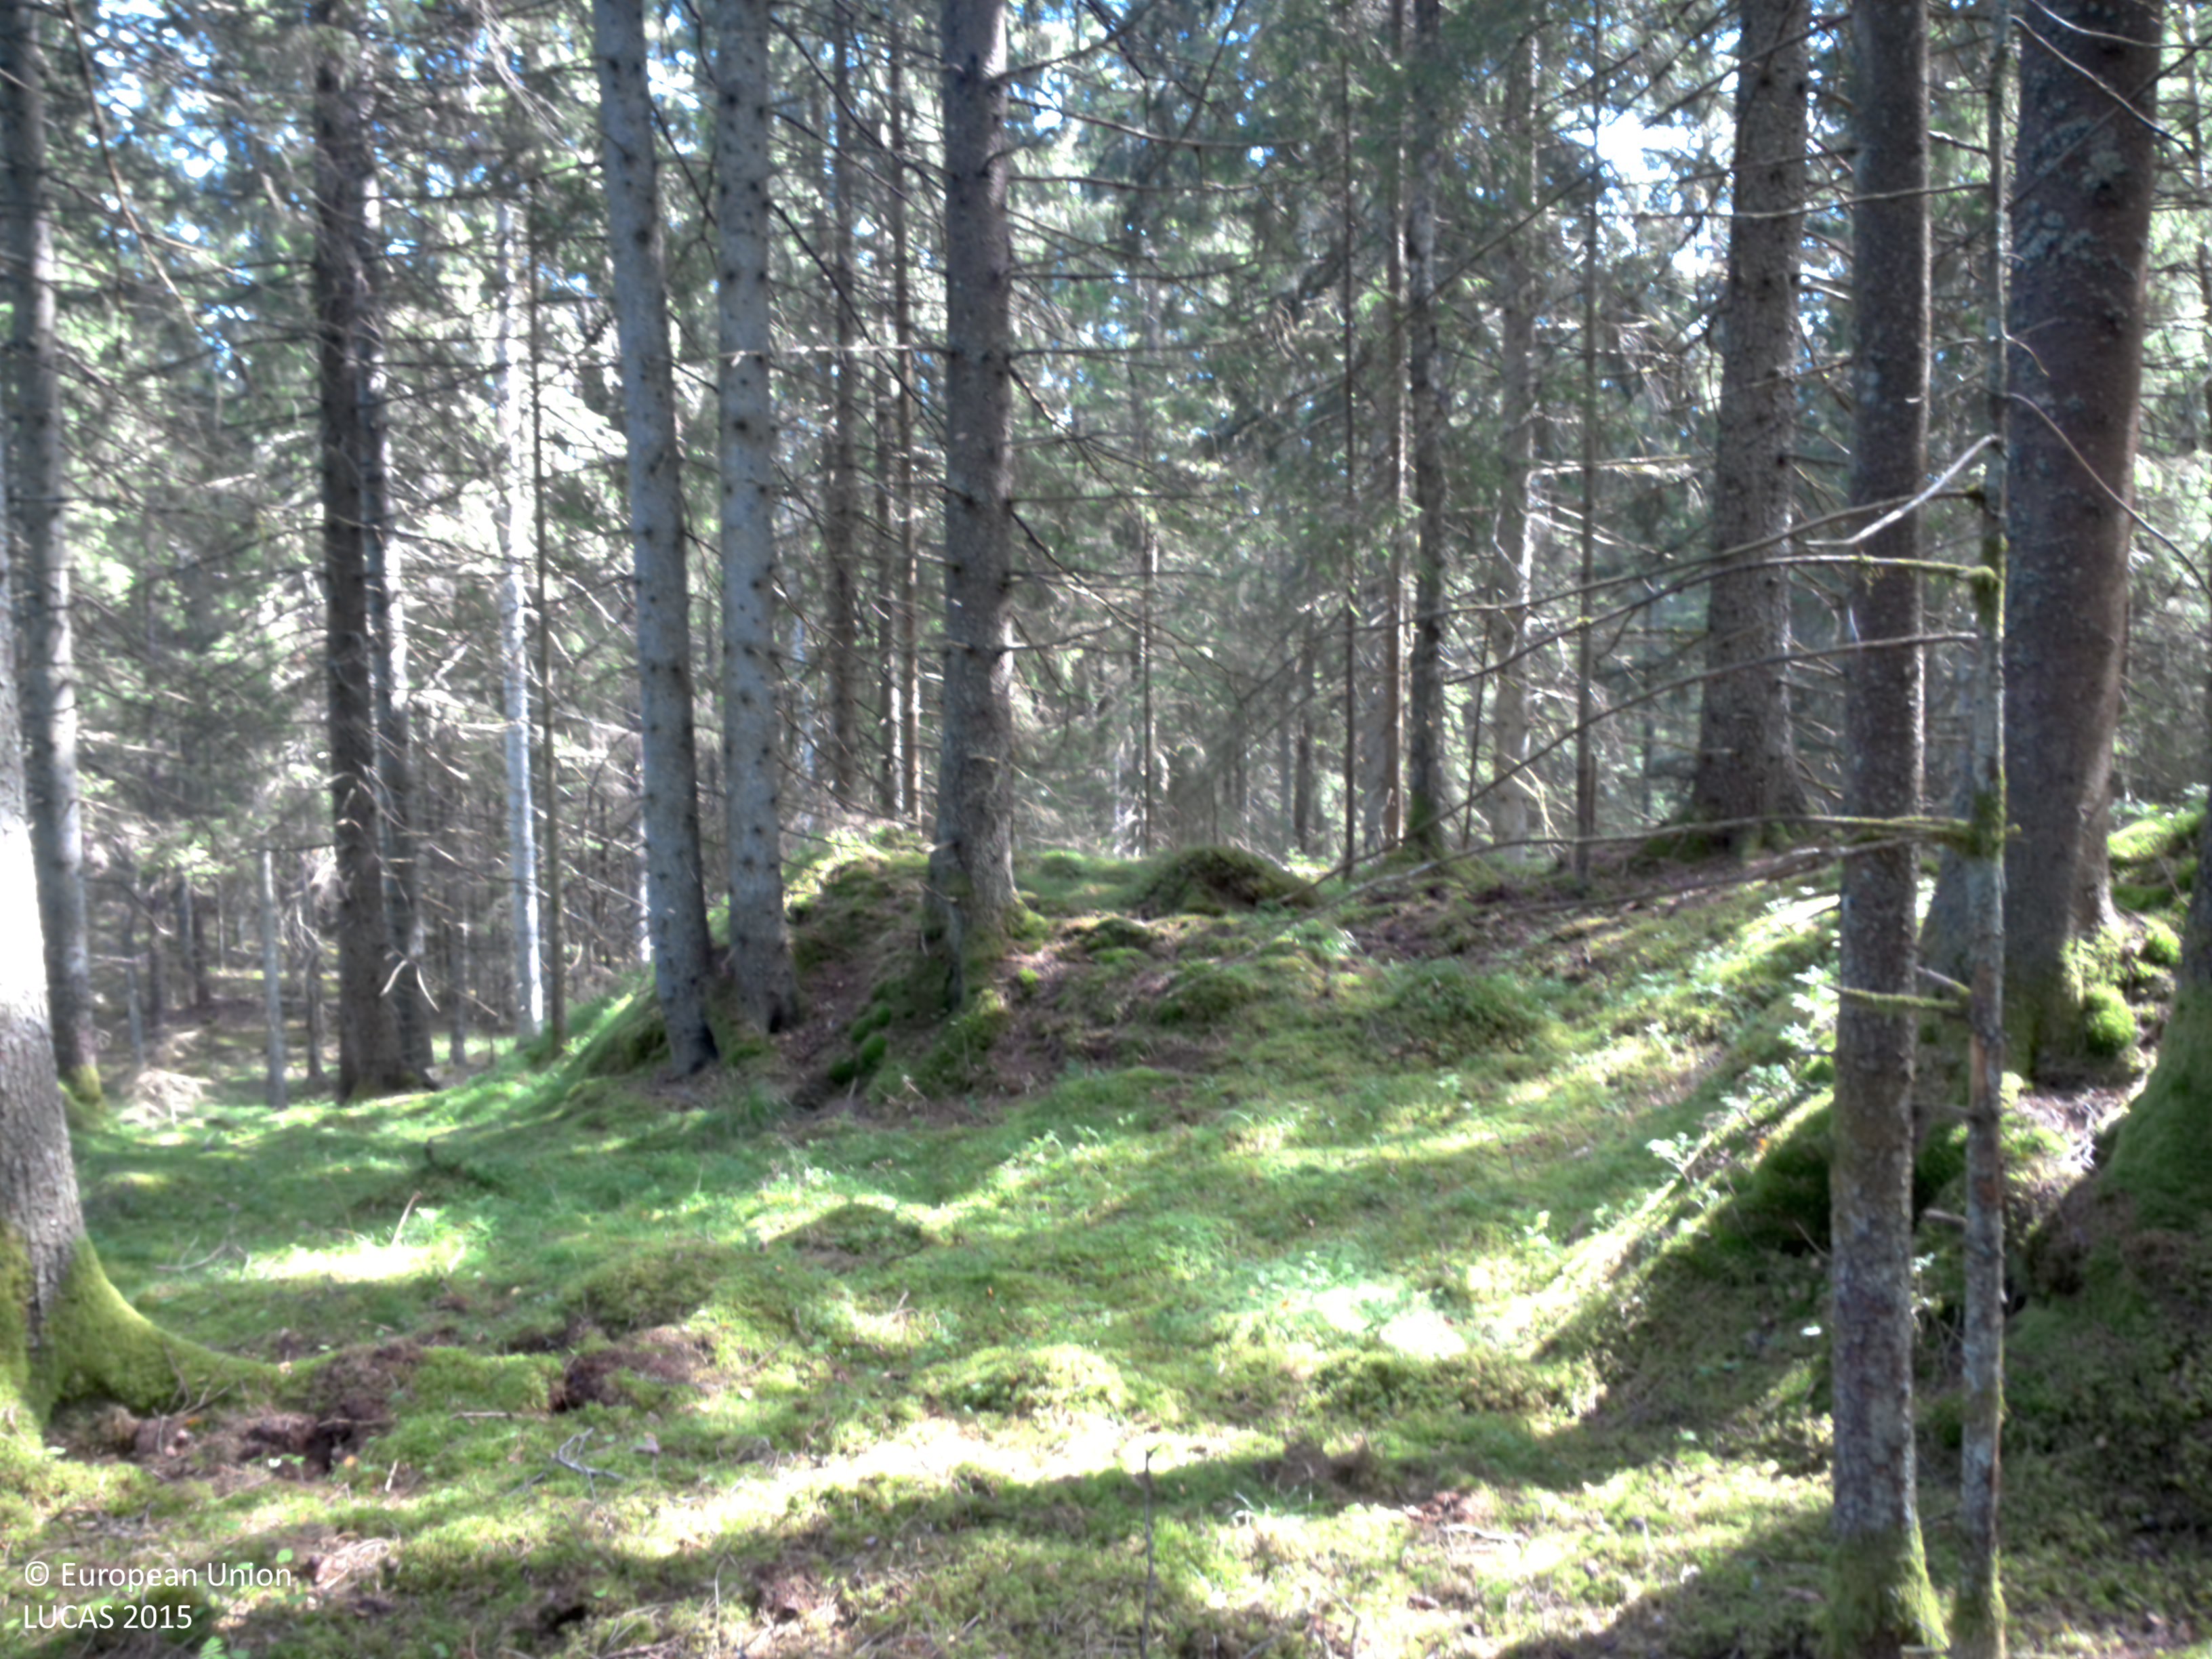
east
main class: Woodland
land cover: Spruce dominated coniferous woodland
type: boreal forest
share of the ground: 50 - 75 %
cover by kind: coniferous forest trees 60 %, lichens and mosses 30 %, shrubs 10 %
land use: Forestry
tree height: > 5 m
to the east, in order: Spruce dominated coniferous woodland; Spruce dominated mixed woodland; Ditches and canals; Spruce dominated coniferous woodland; Ditches and canals; Spruce dominated mixed woodland; Pine dominated mixed woodland
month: August
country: SE
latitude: 58.0017
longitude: 12.3140
